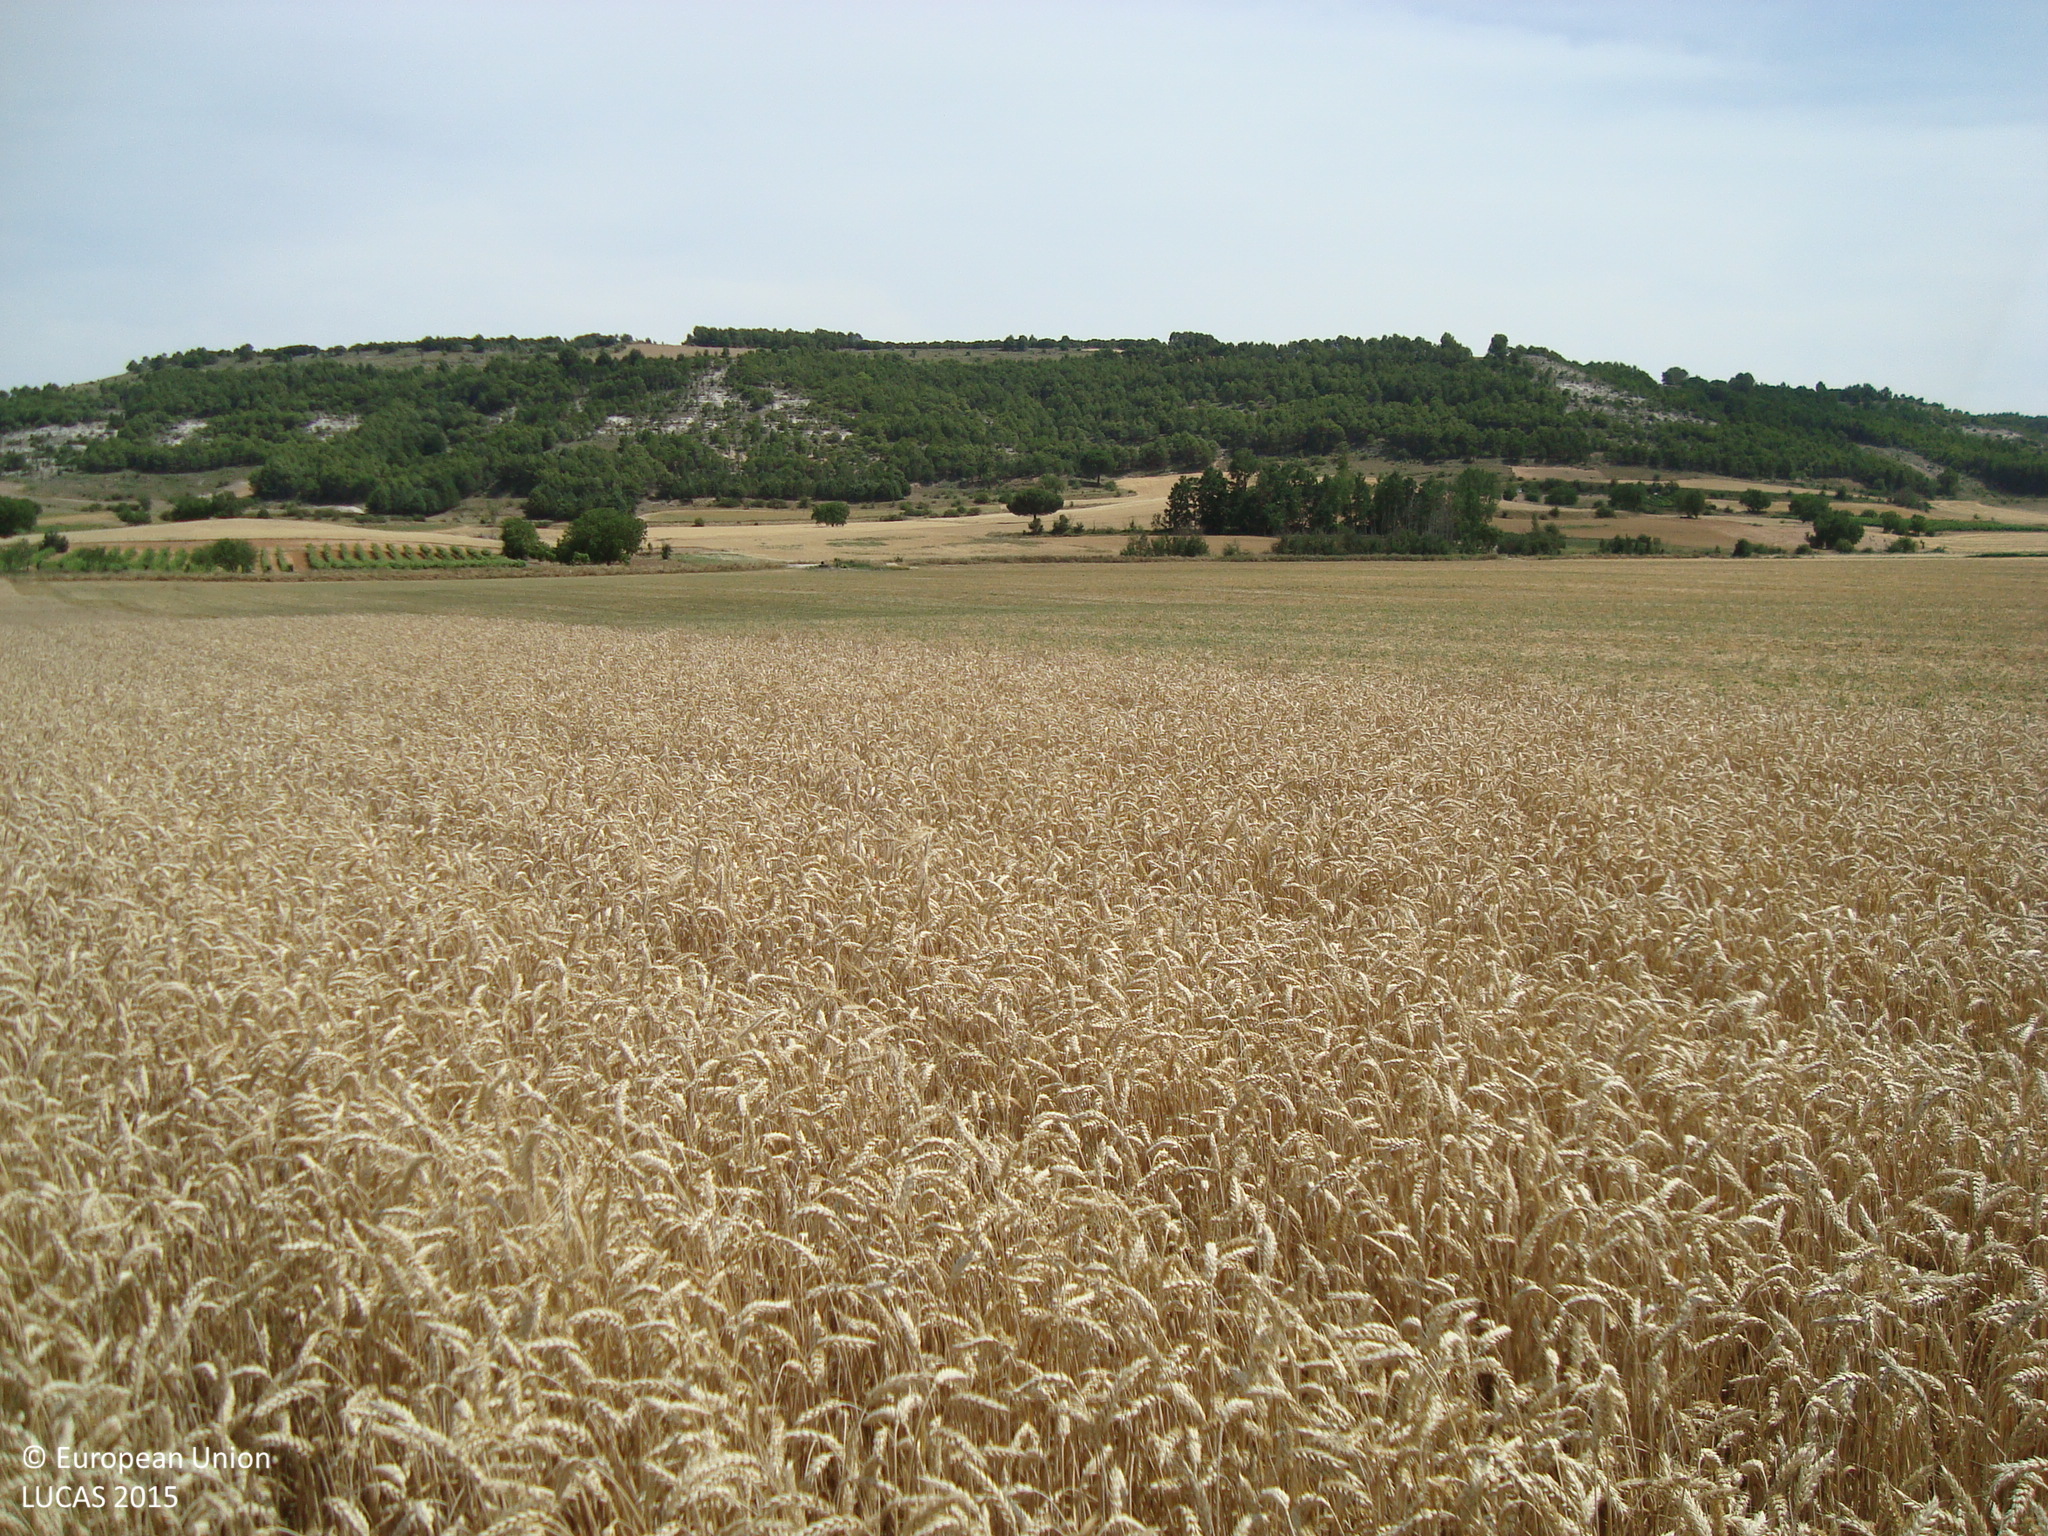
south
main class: Cropland
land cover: Common wheat
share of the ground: > 75 %
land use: Agriculture (excluding fallow land and kitchen gardens)
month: July
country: ES
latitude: 41.7965
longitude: -4.0559
